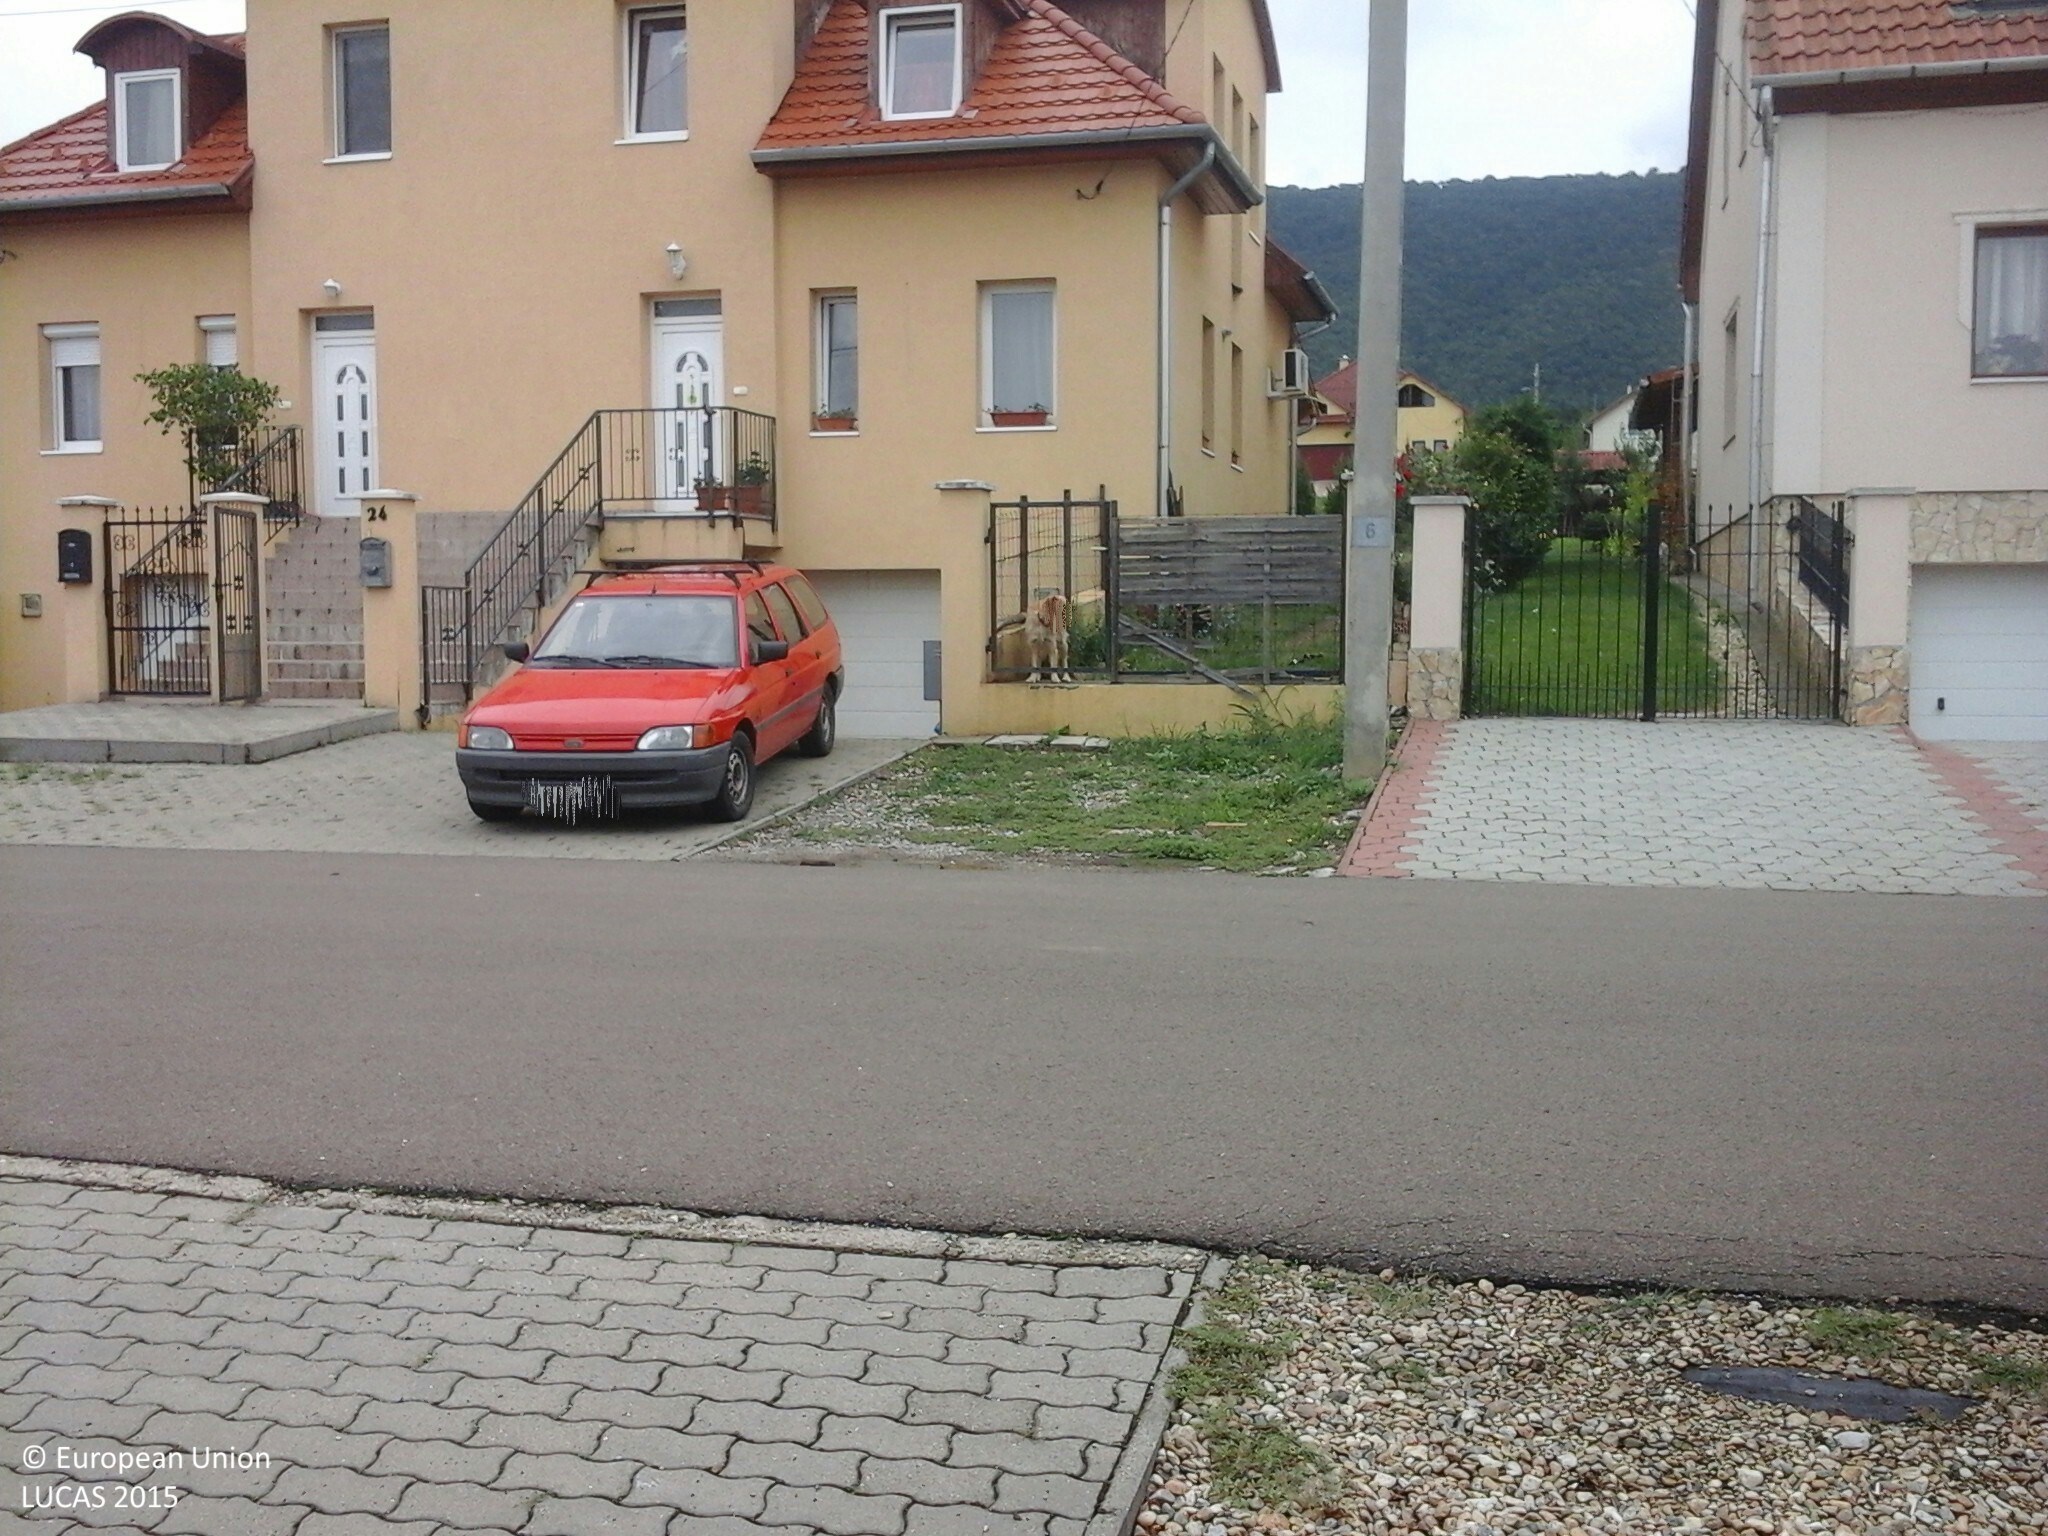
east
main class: Grassland
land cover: Grassland with sparse tree/shrub cover
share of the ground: > 75 %
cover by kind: herbaceous plants 85 %, shrubs 10 %, broadleaved forest trees 5 %
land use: Residential
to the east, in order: Grassland with sparse tree/shrub cover; Artificial constructions in urban areas; Grassland without tree/shrub cover; Electric lines; Ditches and canals; Grass margins; Paved roads, cycling and walking lanes; Grassland without tree/shrub cover; Electric lines; Shrubland with sparse tree cover
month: July
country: HU
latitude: 47.9650
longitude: 20.4120
